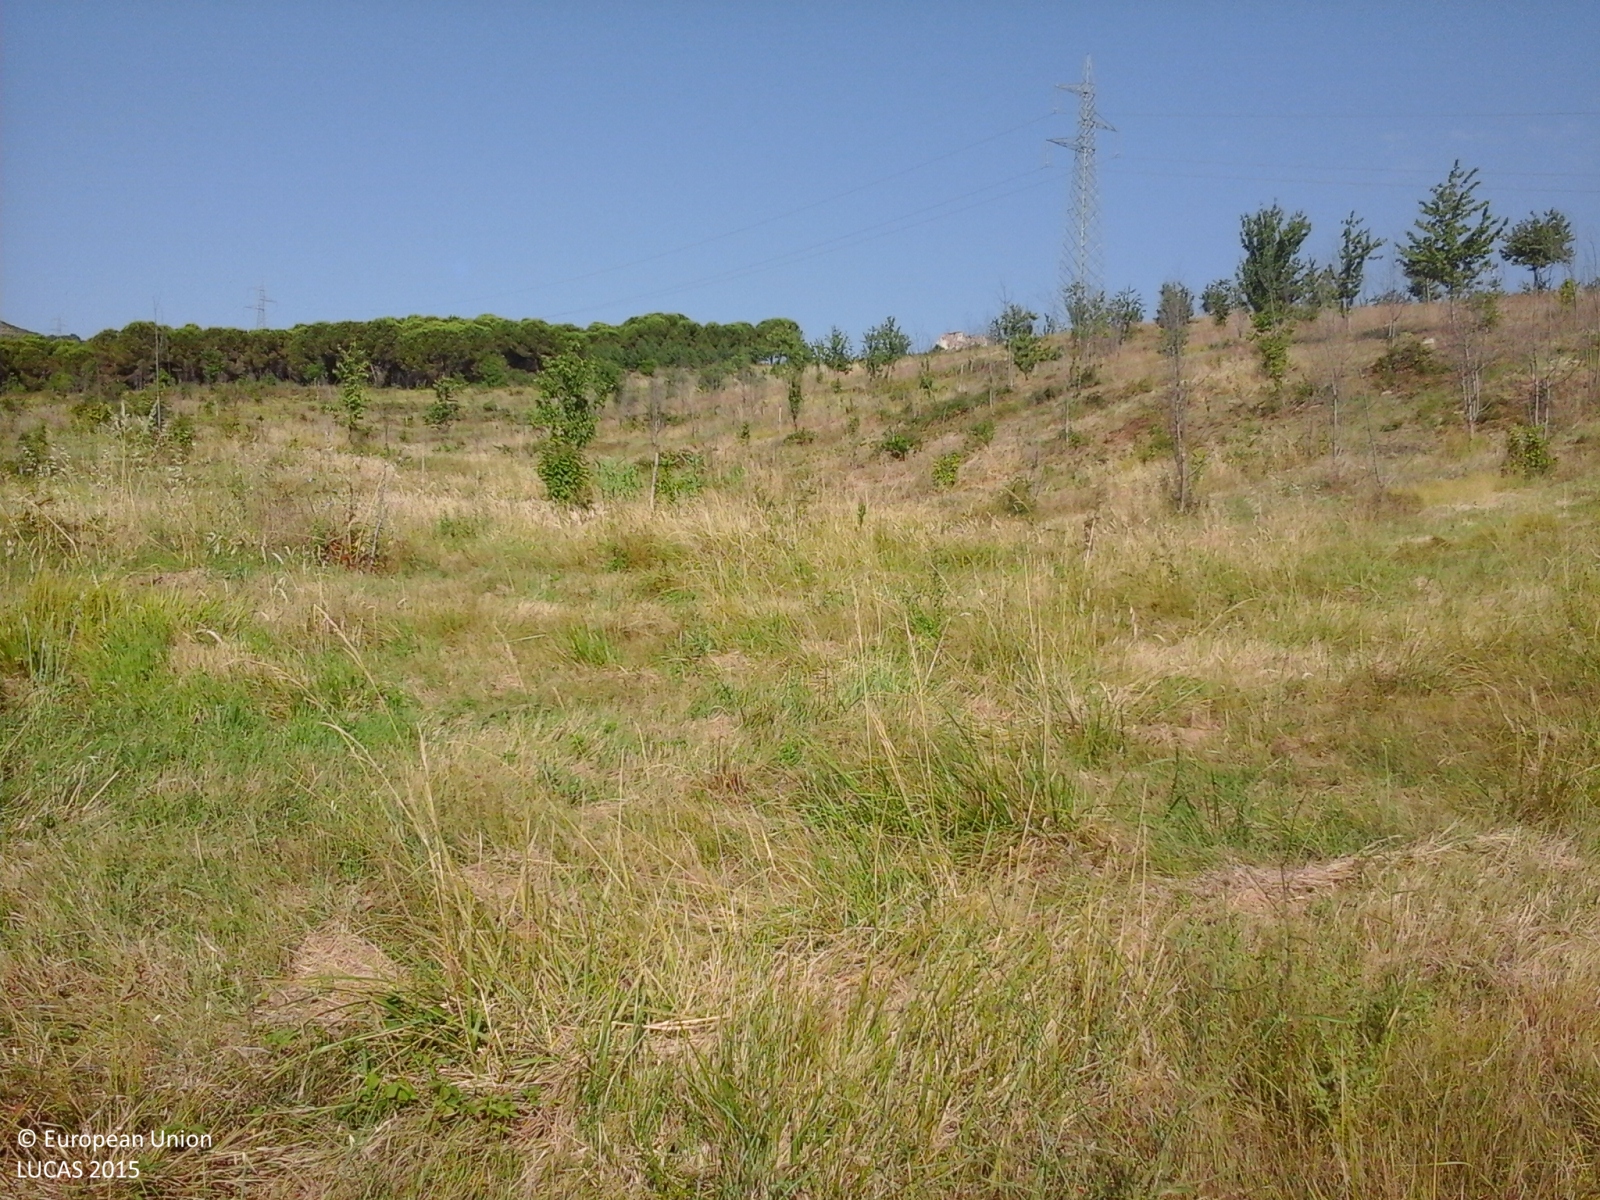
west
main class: Cropland
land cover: Nuts trees
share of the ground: 25 - 50 %
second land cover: Grassland without tree/shrub cover
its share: > 75 %
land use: Agriculture (excluding fallow land and kitchen gardens)
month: July
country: IT
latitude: 41.0977
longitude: 14.6849
